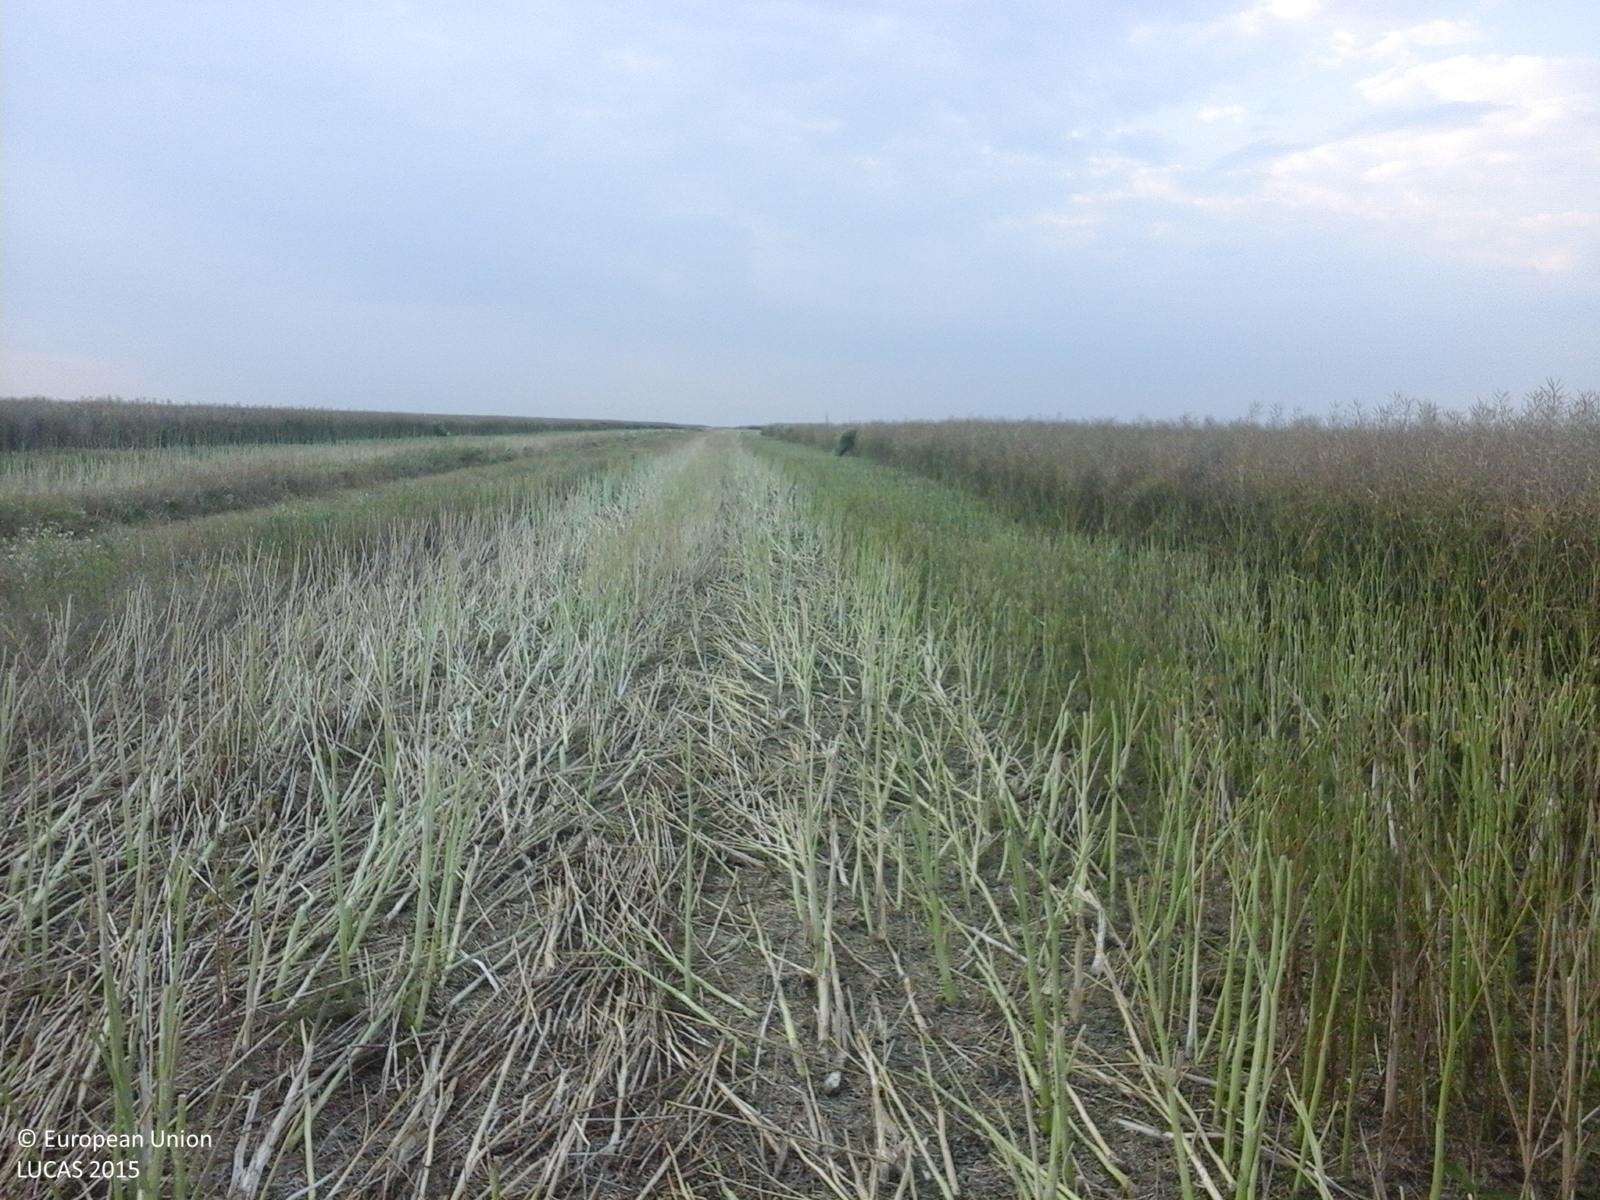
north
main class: Cropland
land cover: Rape and turnip rape
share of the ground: > 75 %
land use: Agriculture (excluding fallow land and kitchen gardens)
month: July
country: RO
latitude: 43.9472
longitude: 24.7611
